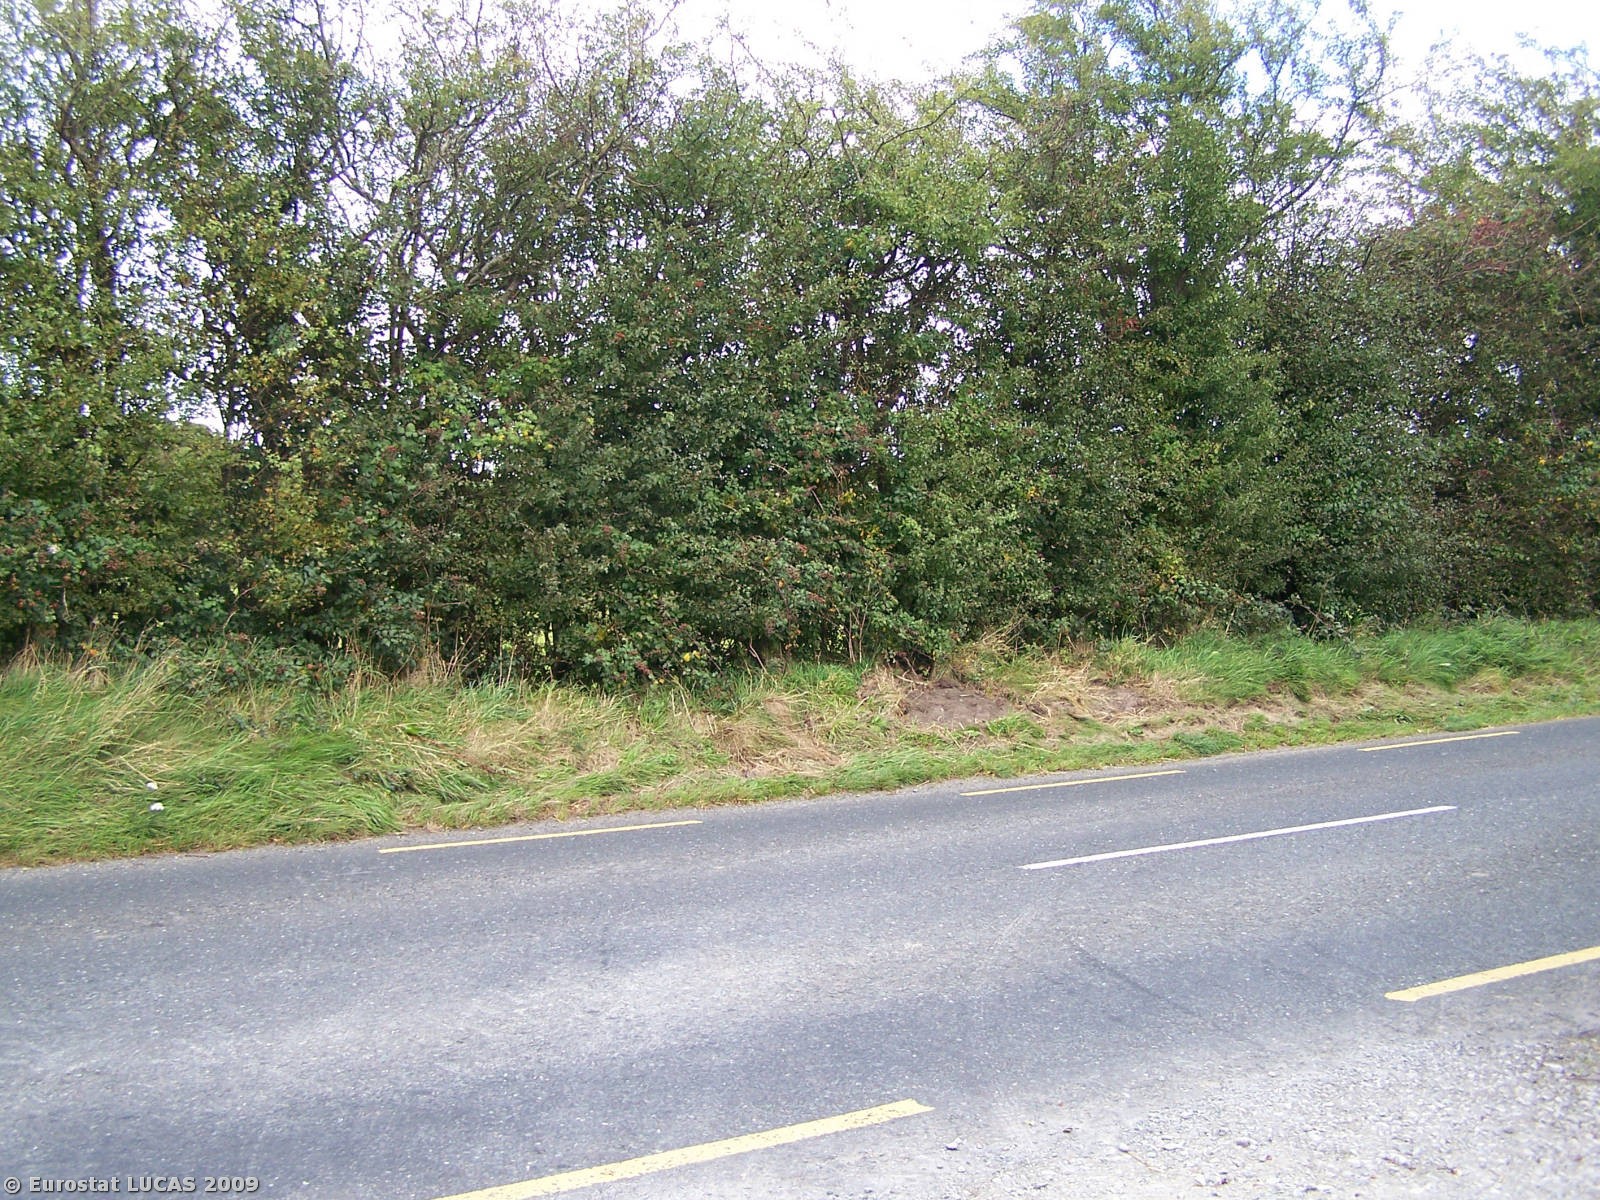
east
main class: Grassland
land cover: Grassland without tree/shrub cover
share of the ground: > 75 %
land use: Agriculture (excluding fallow land and kitchen gardens)
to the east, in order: Grassland without tree/shrub cover; Fences; Dry stone walls; Paved roads, cycling and walking lanes; Managed hedges; Grassland without tree/shrub cover; Managed hedges; Grassland without tree/shrub cover
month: September
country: IE
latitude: 52.4027
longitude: -8.3711
